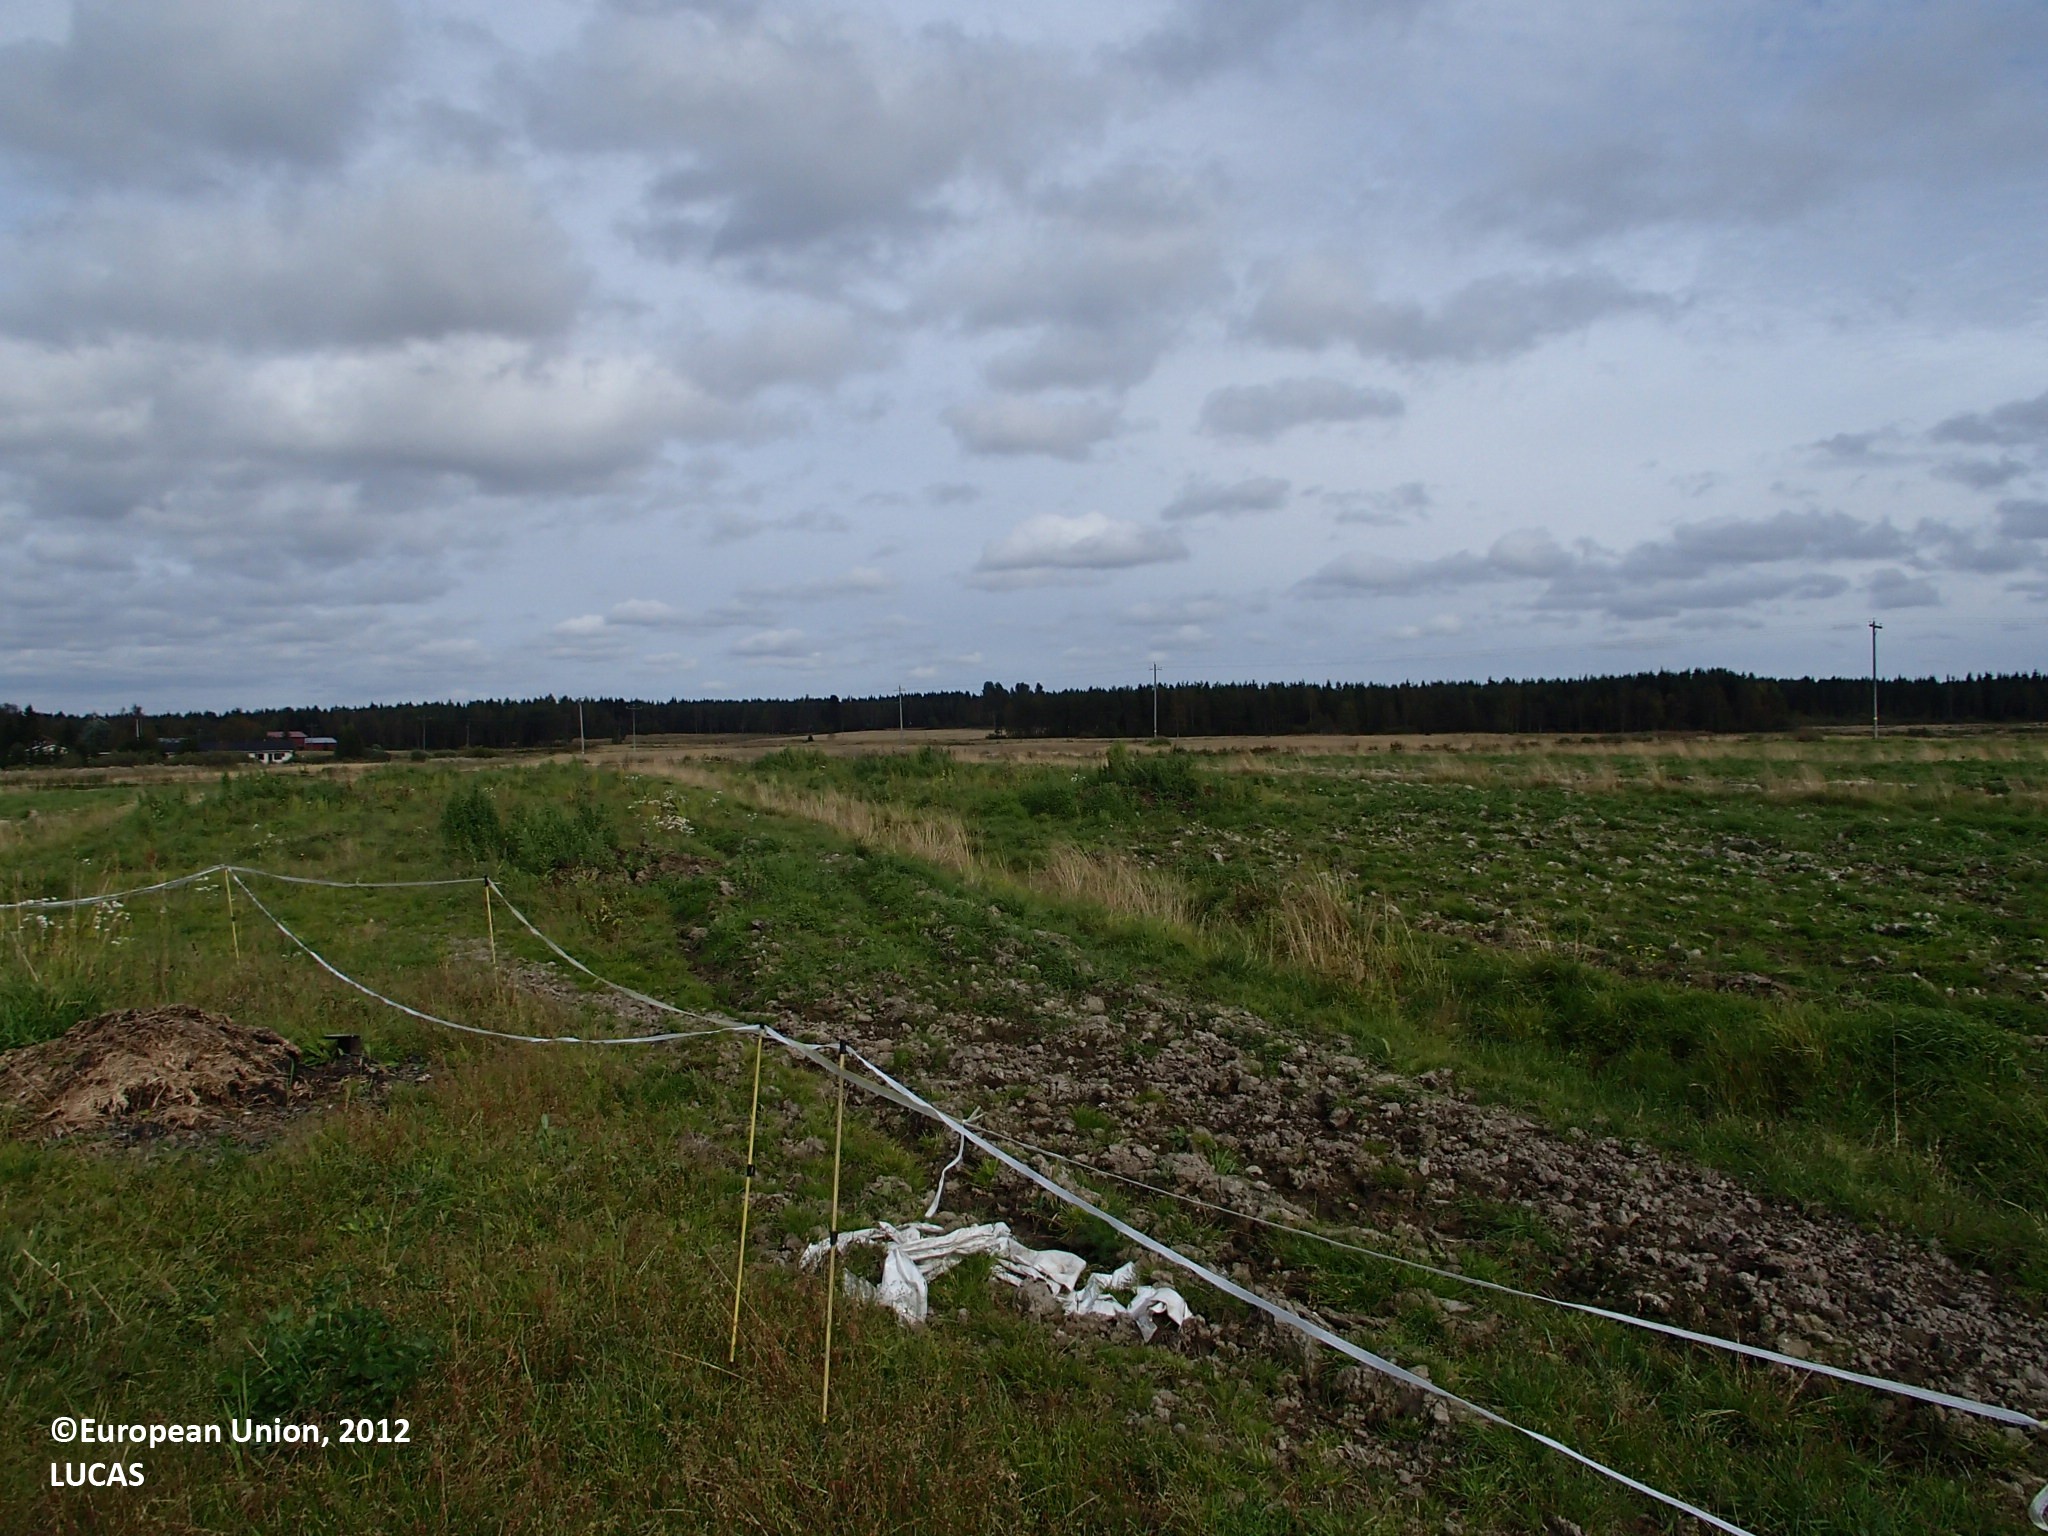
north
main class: Cropland
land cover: Temporary grasslands
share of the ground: > 75 %
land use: Agriculture (excluding fallow land and kitchen gardens)
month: September
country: FI
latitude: 63.7864
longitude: 25.9566
